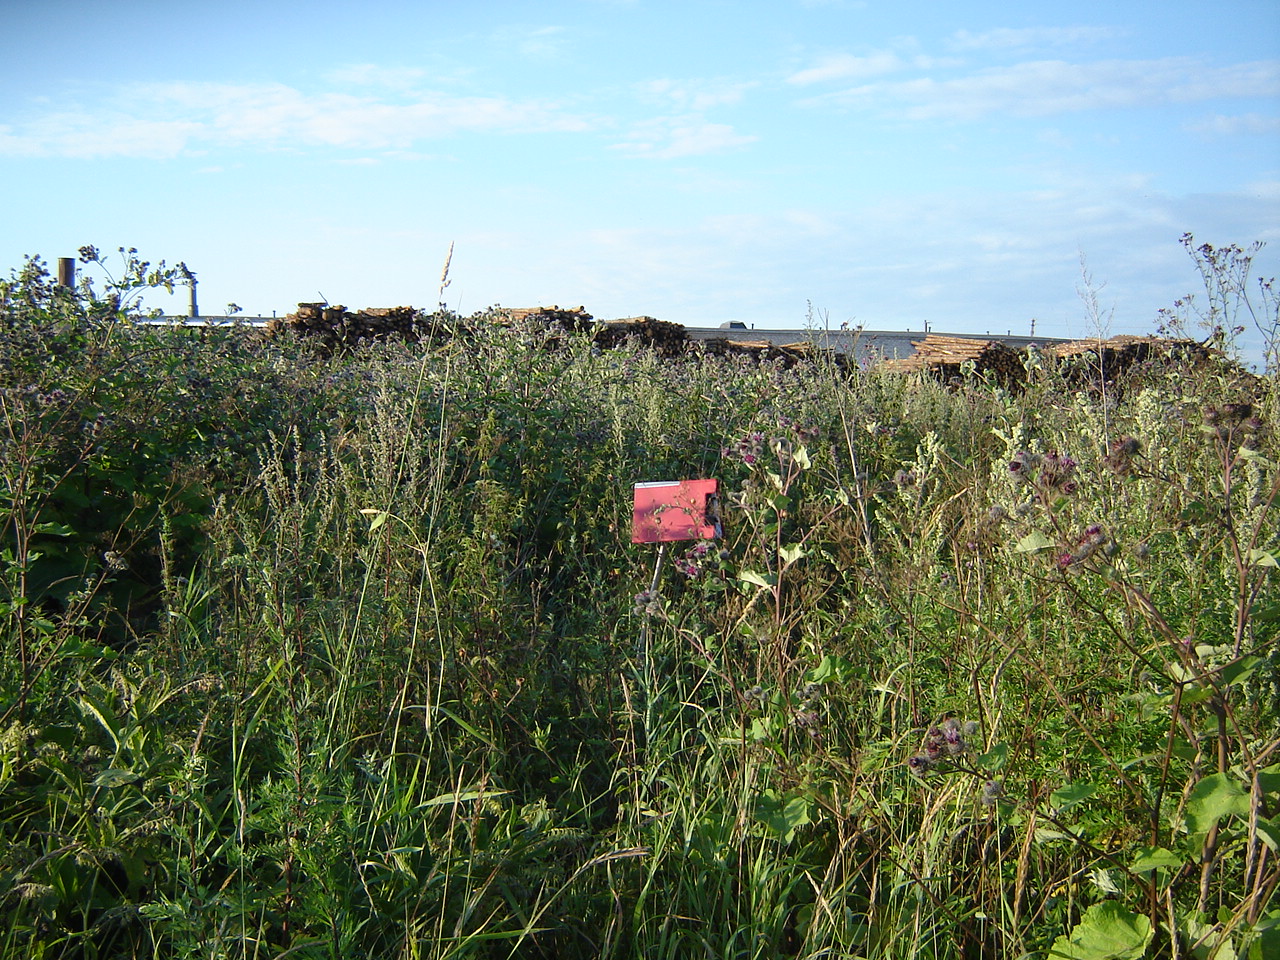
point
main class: Grassland
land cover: Spontaneously vegetated surfaces
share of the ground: > 75 %
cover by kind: herbaceous plants 100 %
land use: Fallow land
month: July
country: LT
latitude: 55.2972
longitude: 24.7055
